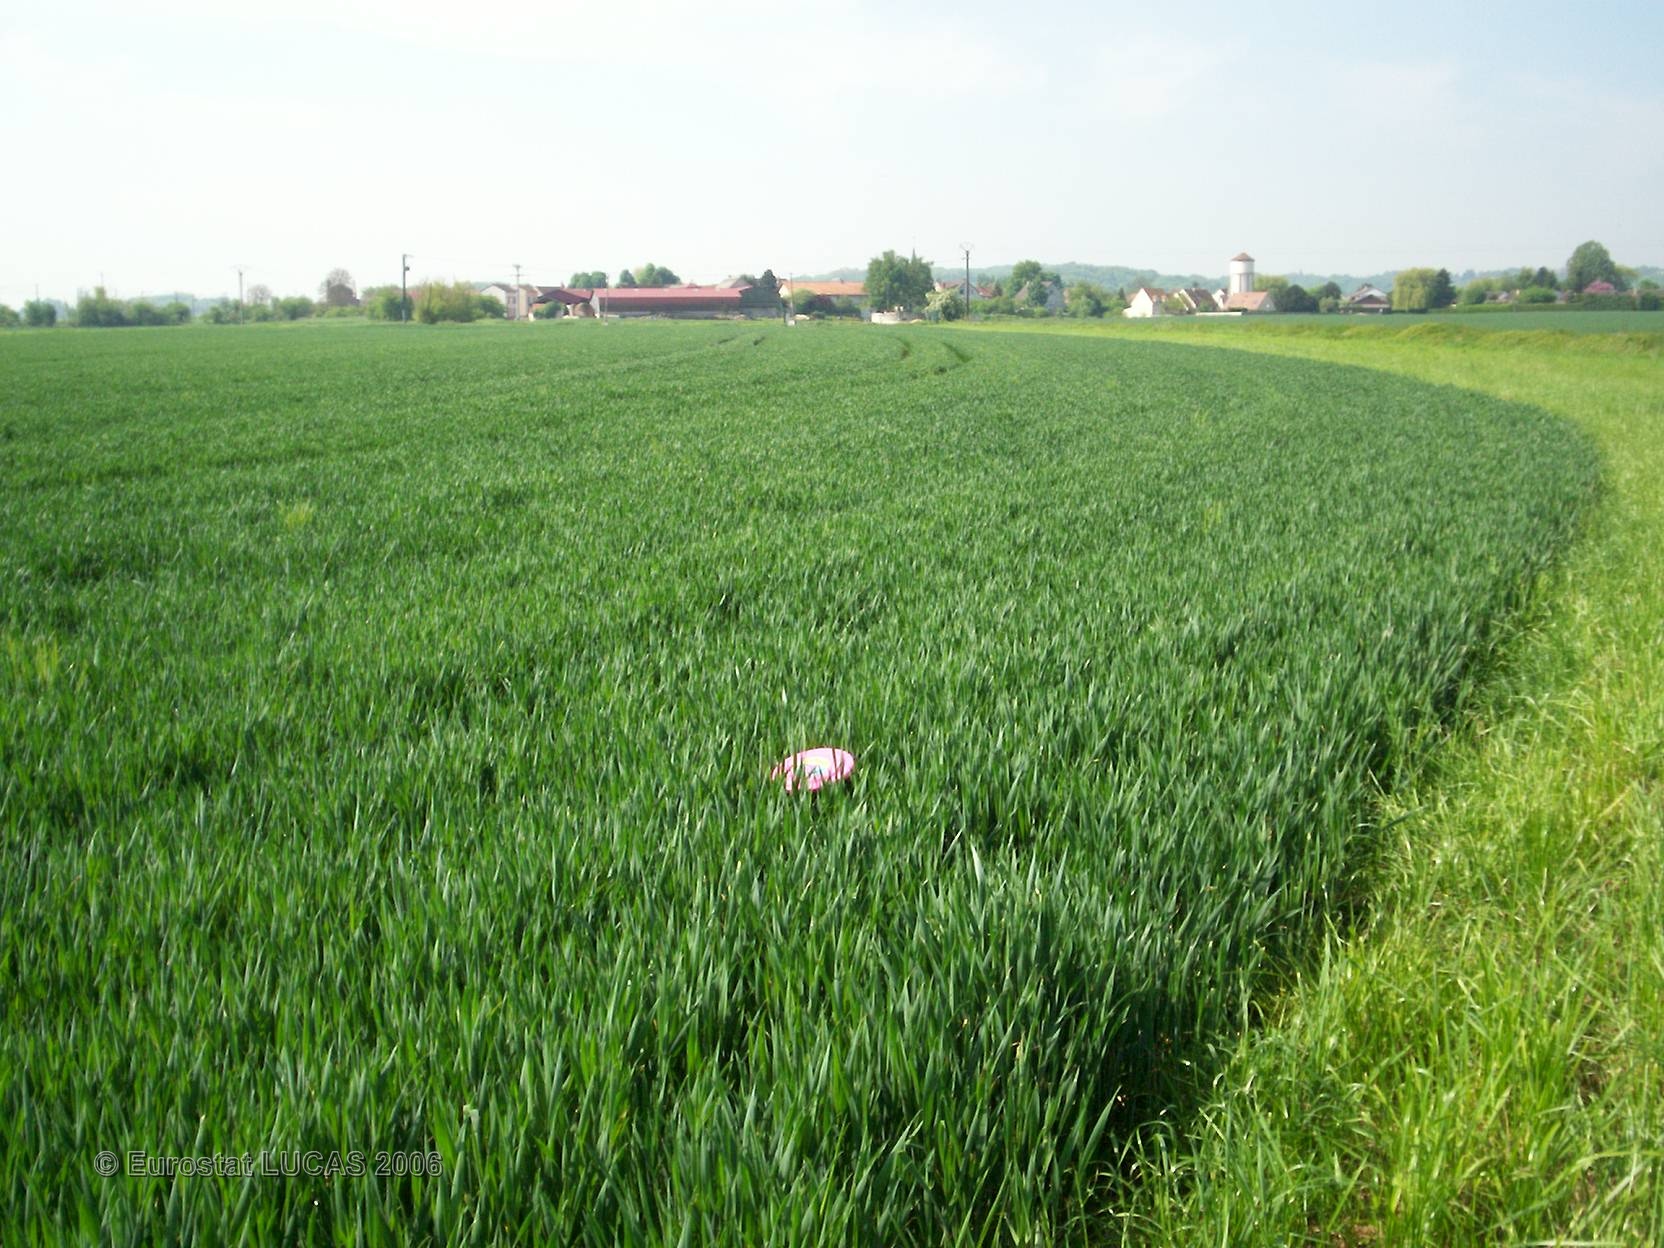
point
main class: Cropland
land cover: Common wheat
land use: Agriculture (excluding fallow land and kitchen gardens)
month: May
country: FR
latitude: 49.0667
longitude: 2.7218
